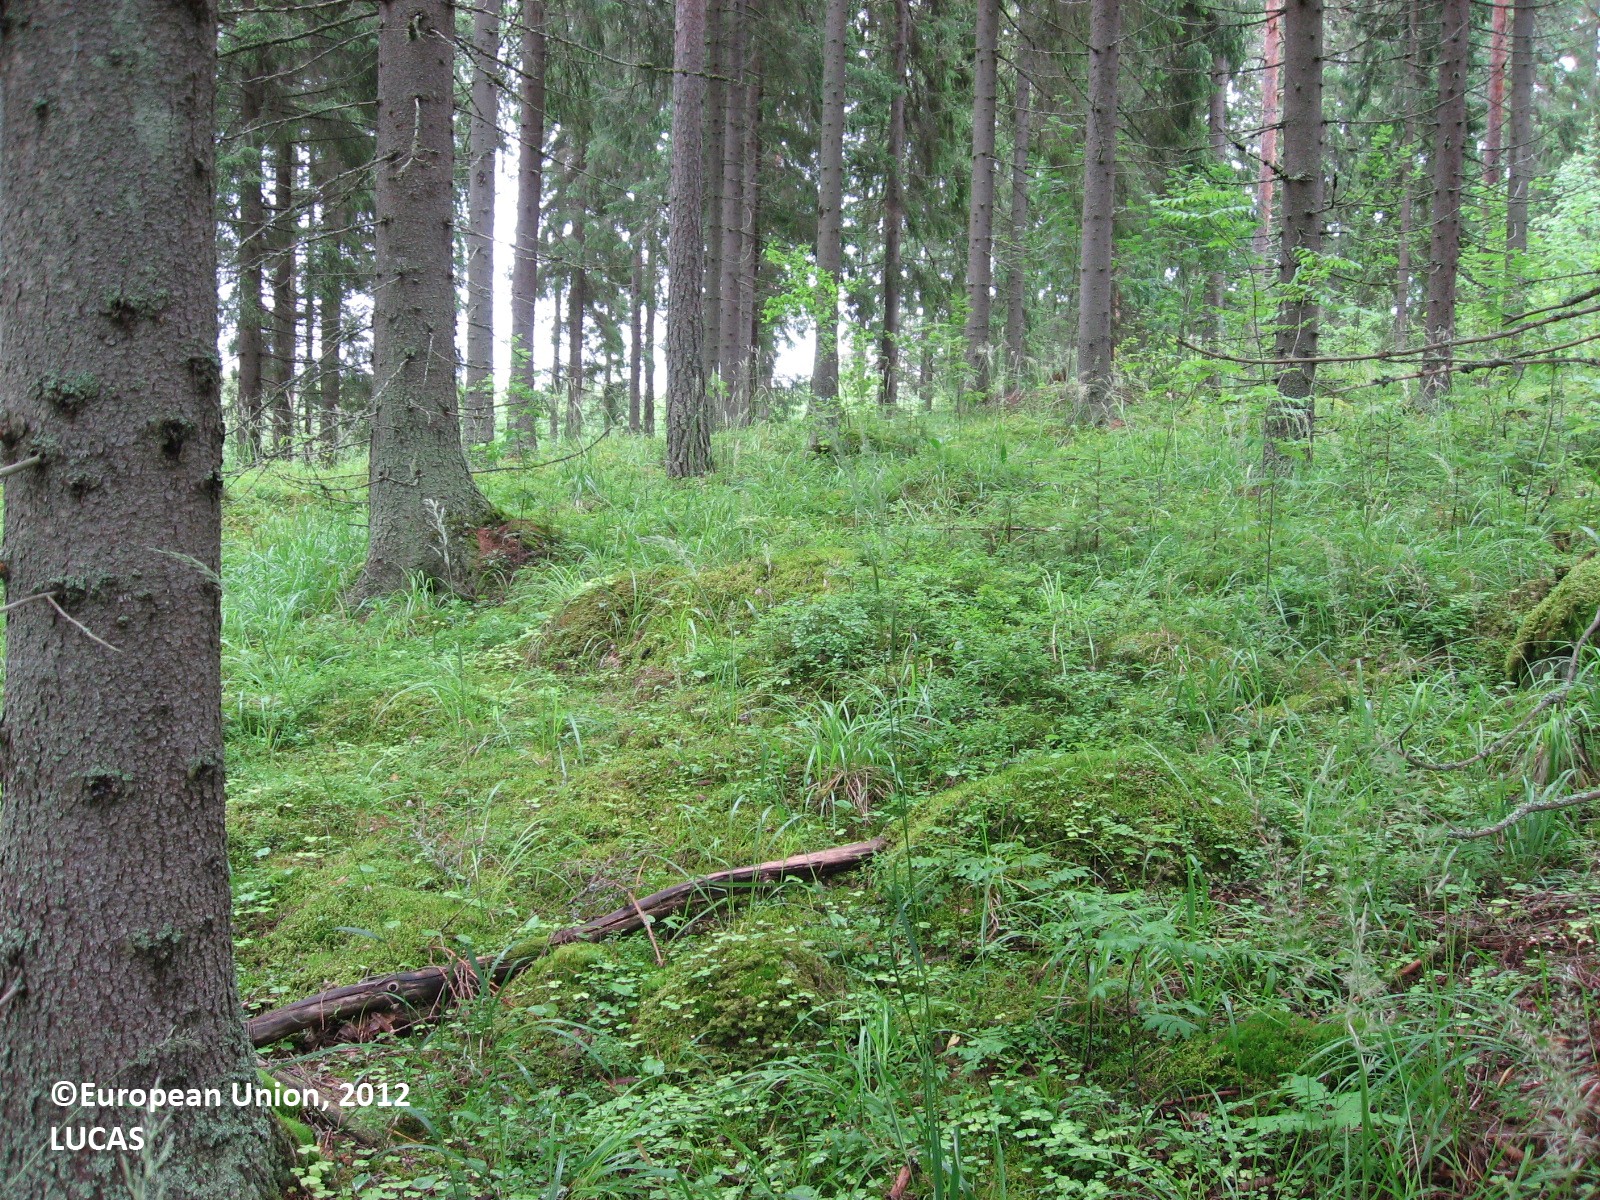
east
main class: Woodland
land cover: Spruce dominated coniferous woodland
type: boreal forest
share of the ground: 50 - 75 %
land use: Forestry
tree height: > 5 m
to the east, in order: Spruce dominated coniferous woodland; Electric lines; Paved roads, cycling and walking lanes; Grass margins; Other mixed woodland; Spontaneously vegetated surfaces; Other mixed woodland; Spontaneously vegetated surfaces; Spruce dominated coniferous woodland
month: July
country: FI
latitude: 61.2271
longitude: 25.8700
